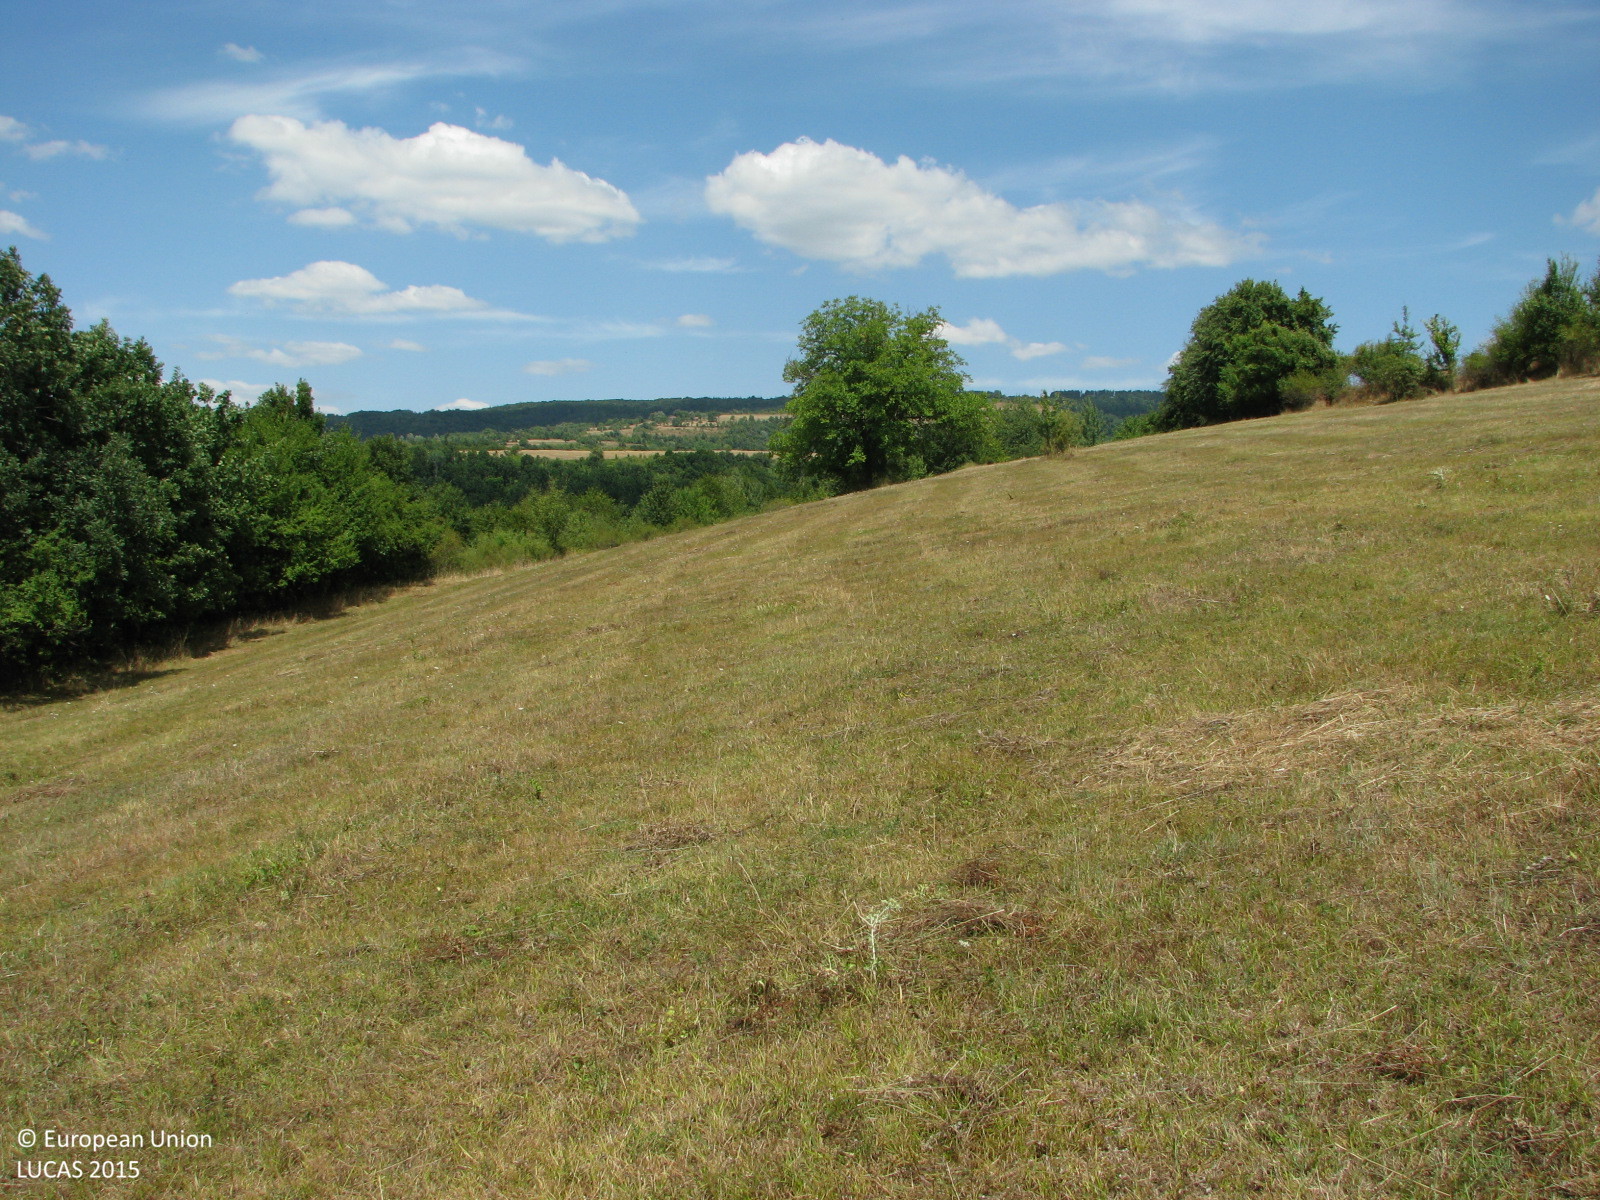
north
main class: Grassland
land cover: Grassland without tree/shrub cover
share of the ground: > 75 %
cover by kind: herbaceous plants 100 %
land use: Agriculture (excluding fallow land and kitchen gardens)
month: August
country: BG
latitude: 42.9691
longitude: 26.2392
